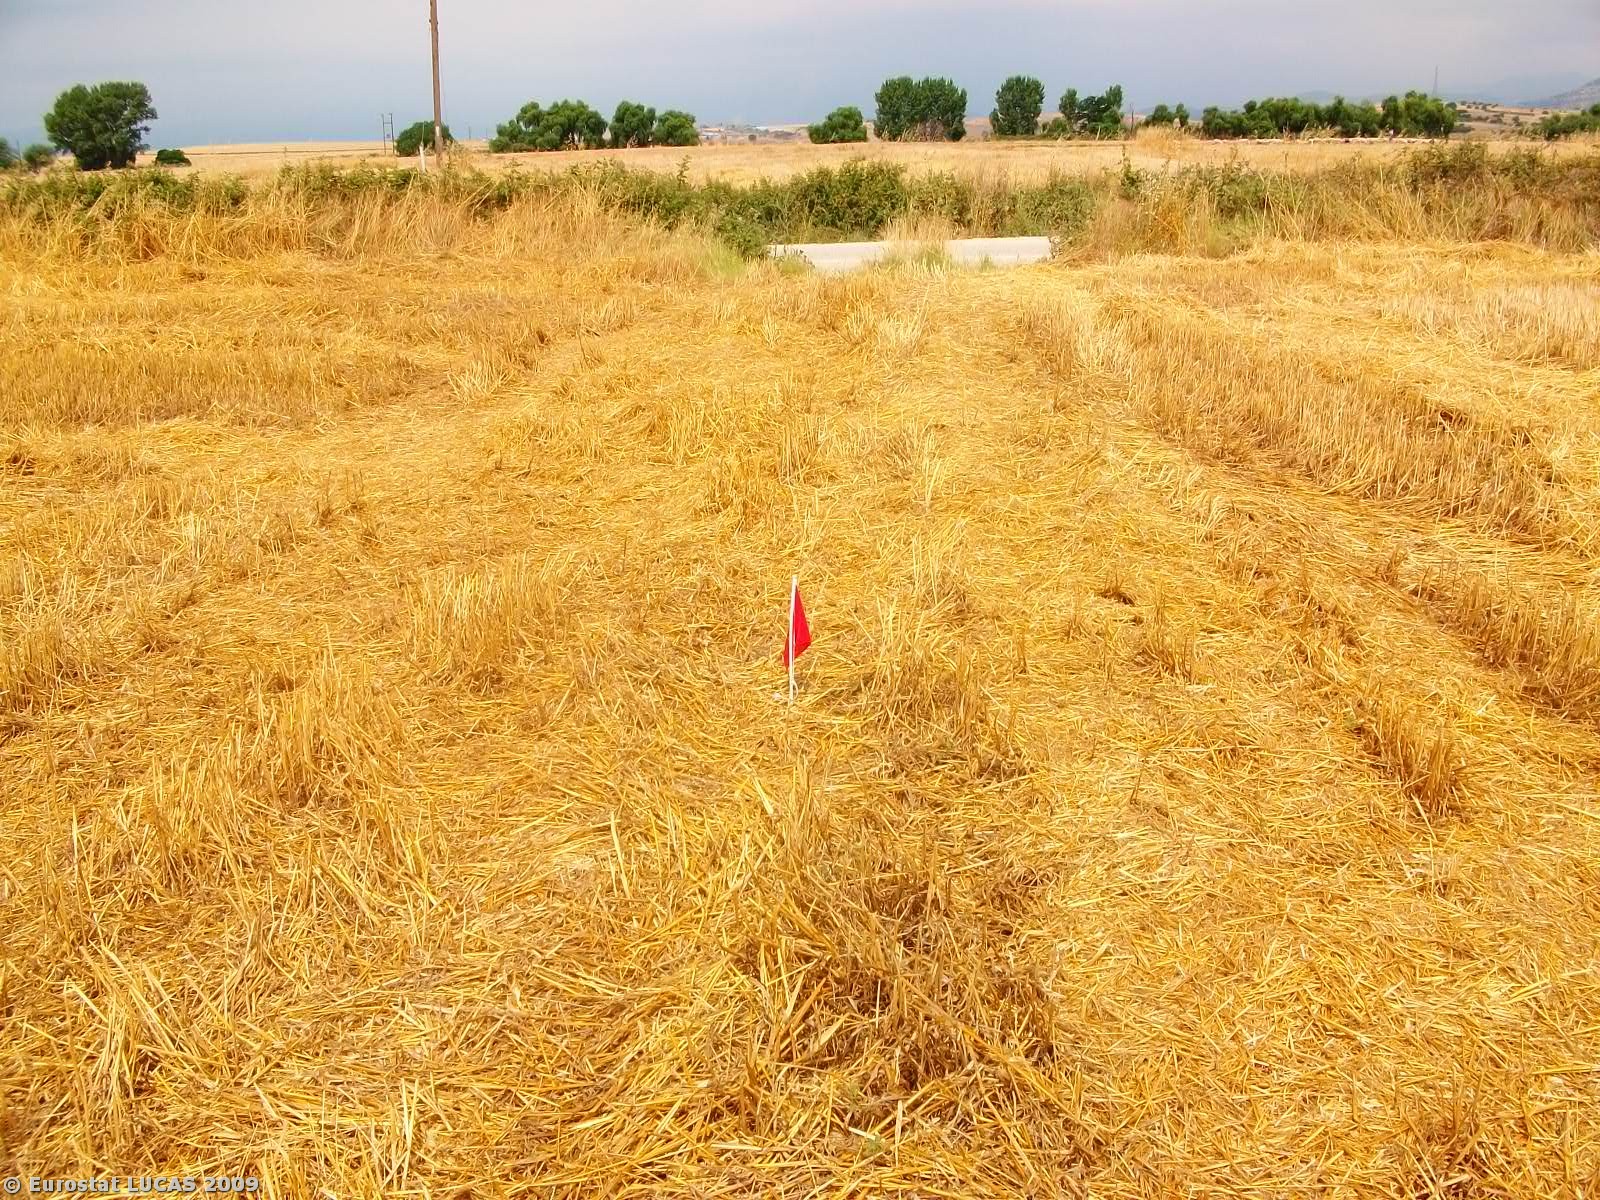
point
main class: Cropland
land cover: Durum wheat
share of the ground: > 75 %
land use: Agriculture (excluding fallow land and kitchen gardens)
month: June
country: GR
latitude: 41.0490
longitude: 23.6433
